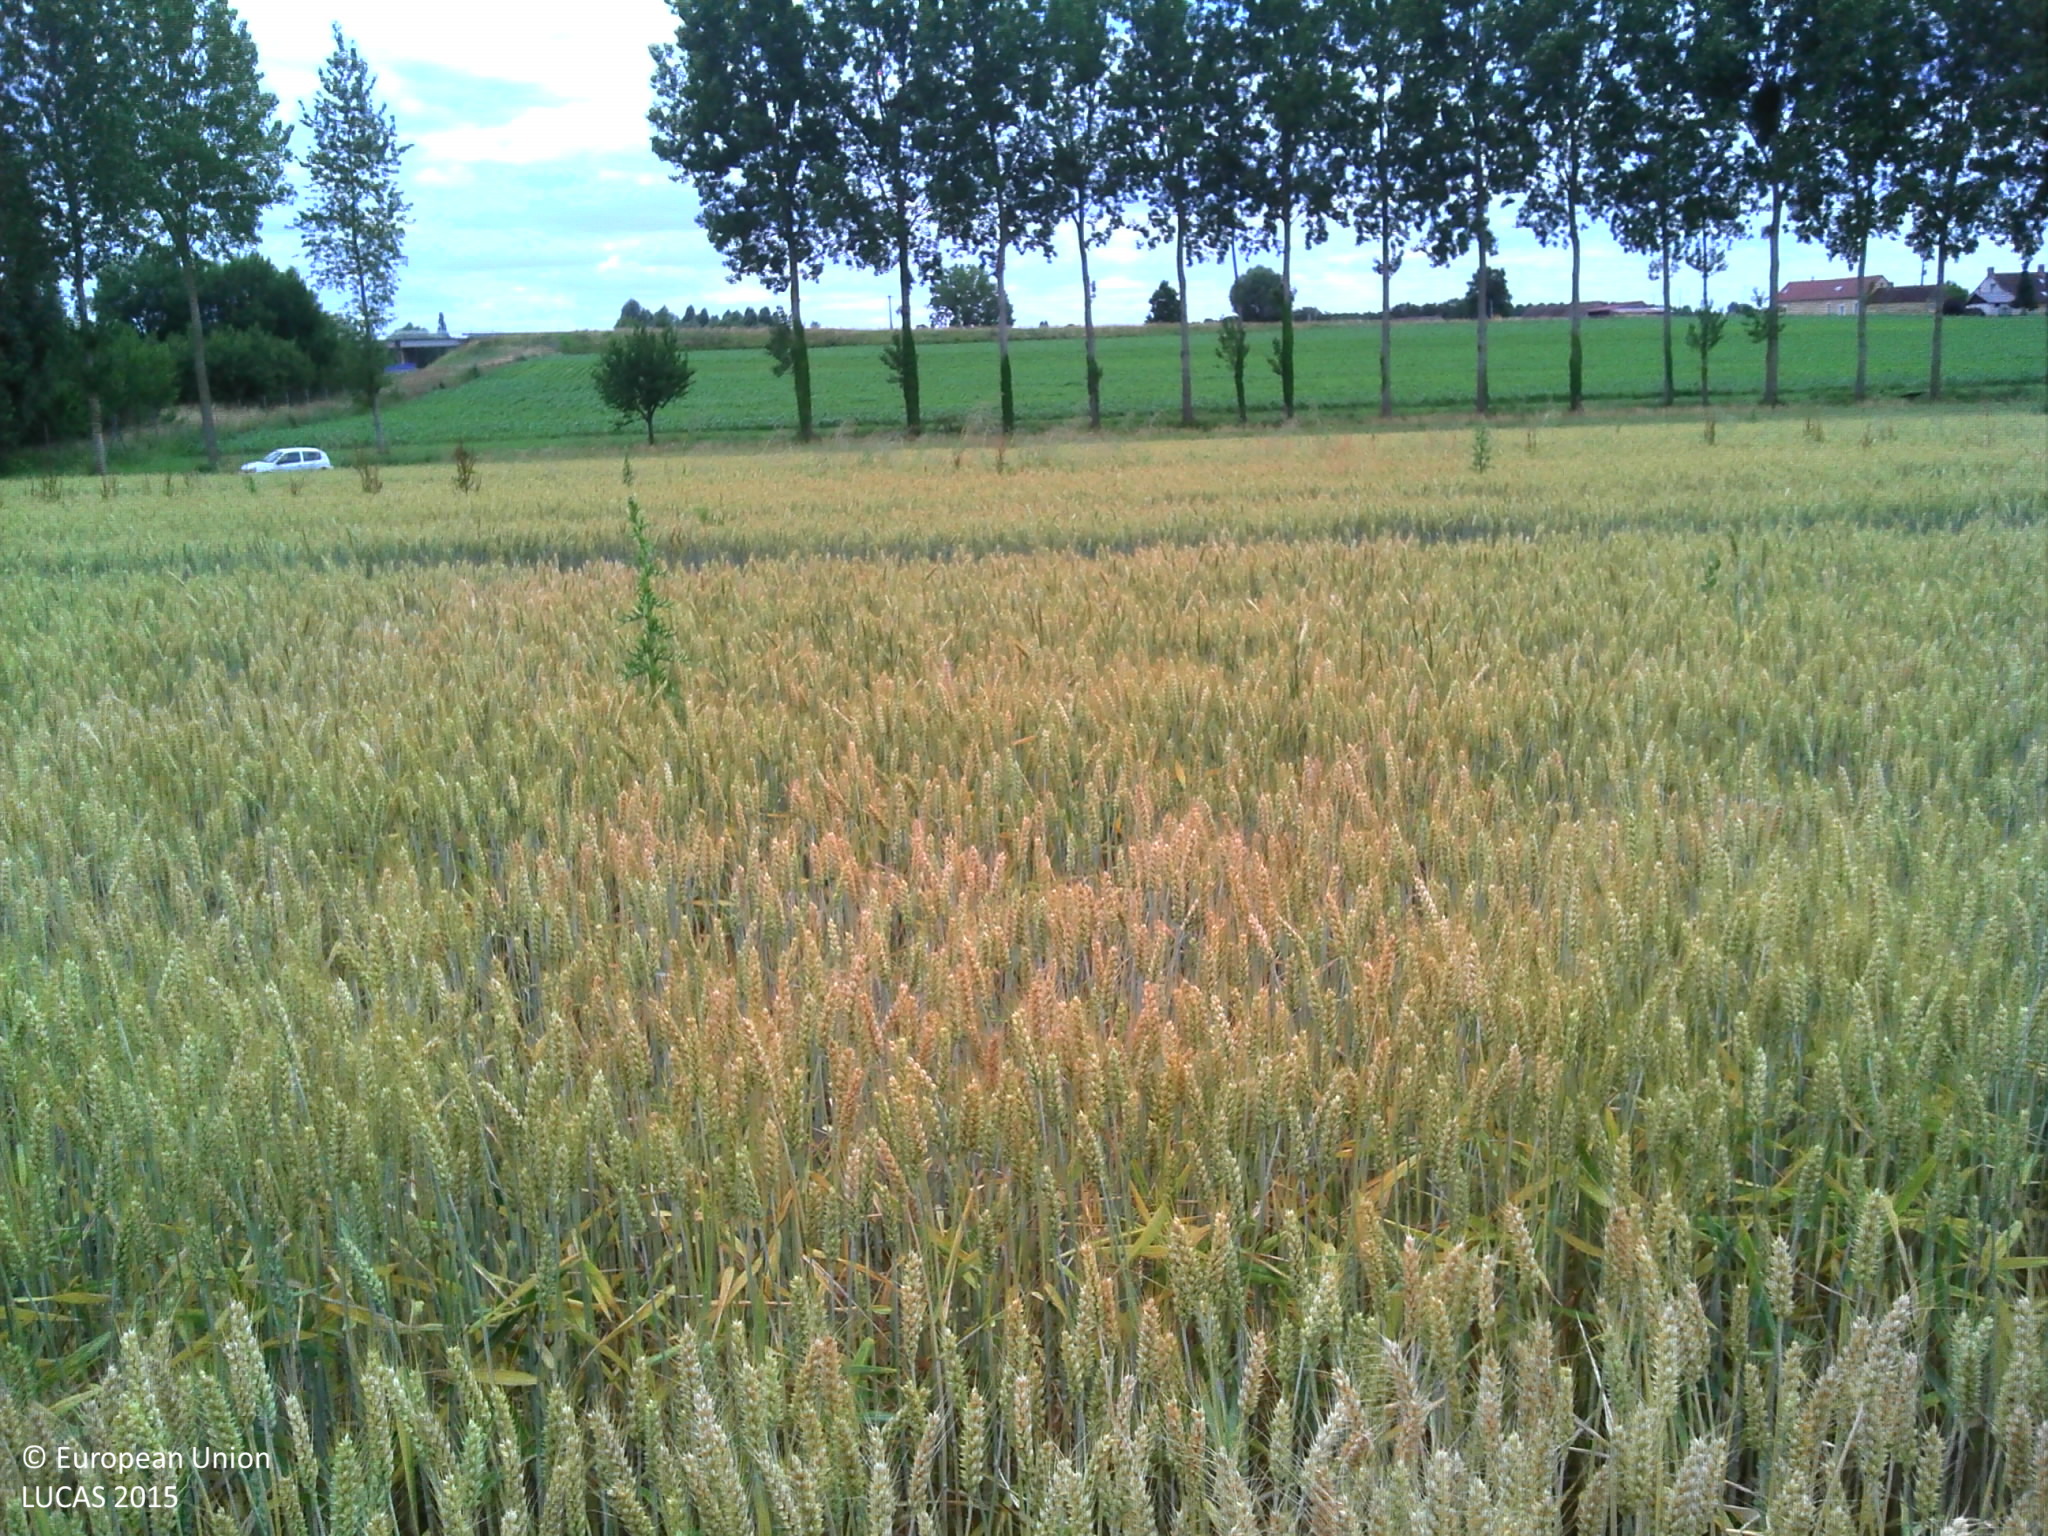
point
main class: Cropland
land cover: Common wheat
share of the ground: > 75 %
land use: Agriculture (excluding fallow land and kitchen gardens)
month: June
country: FR
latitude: 47.9039
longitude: 0.3031
